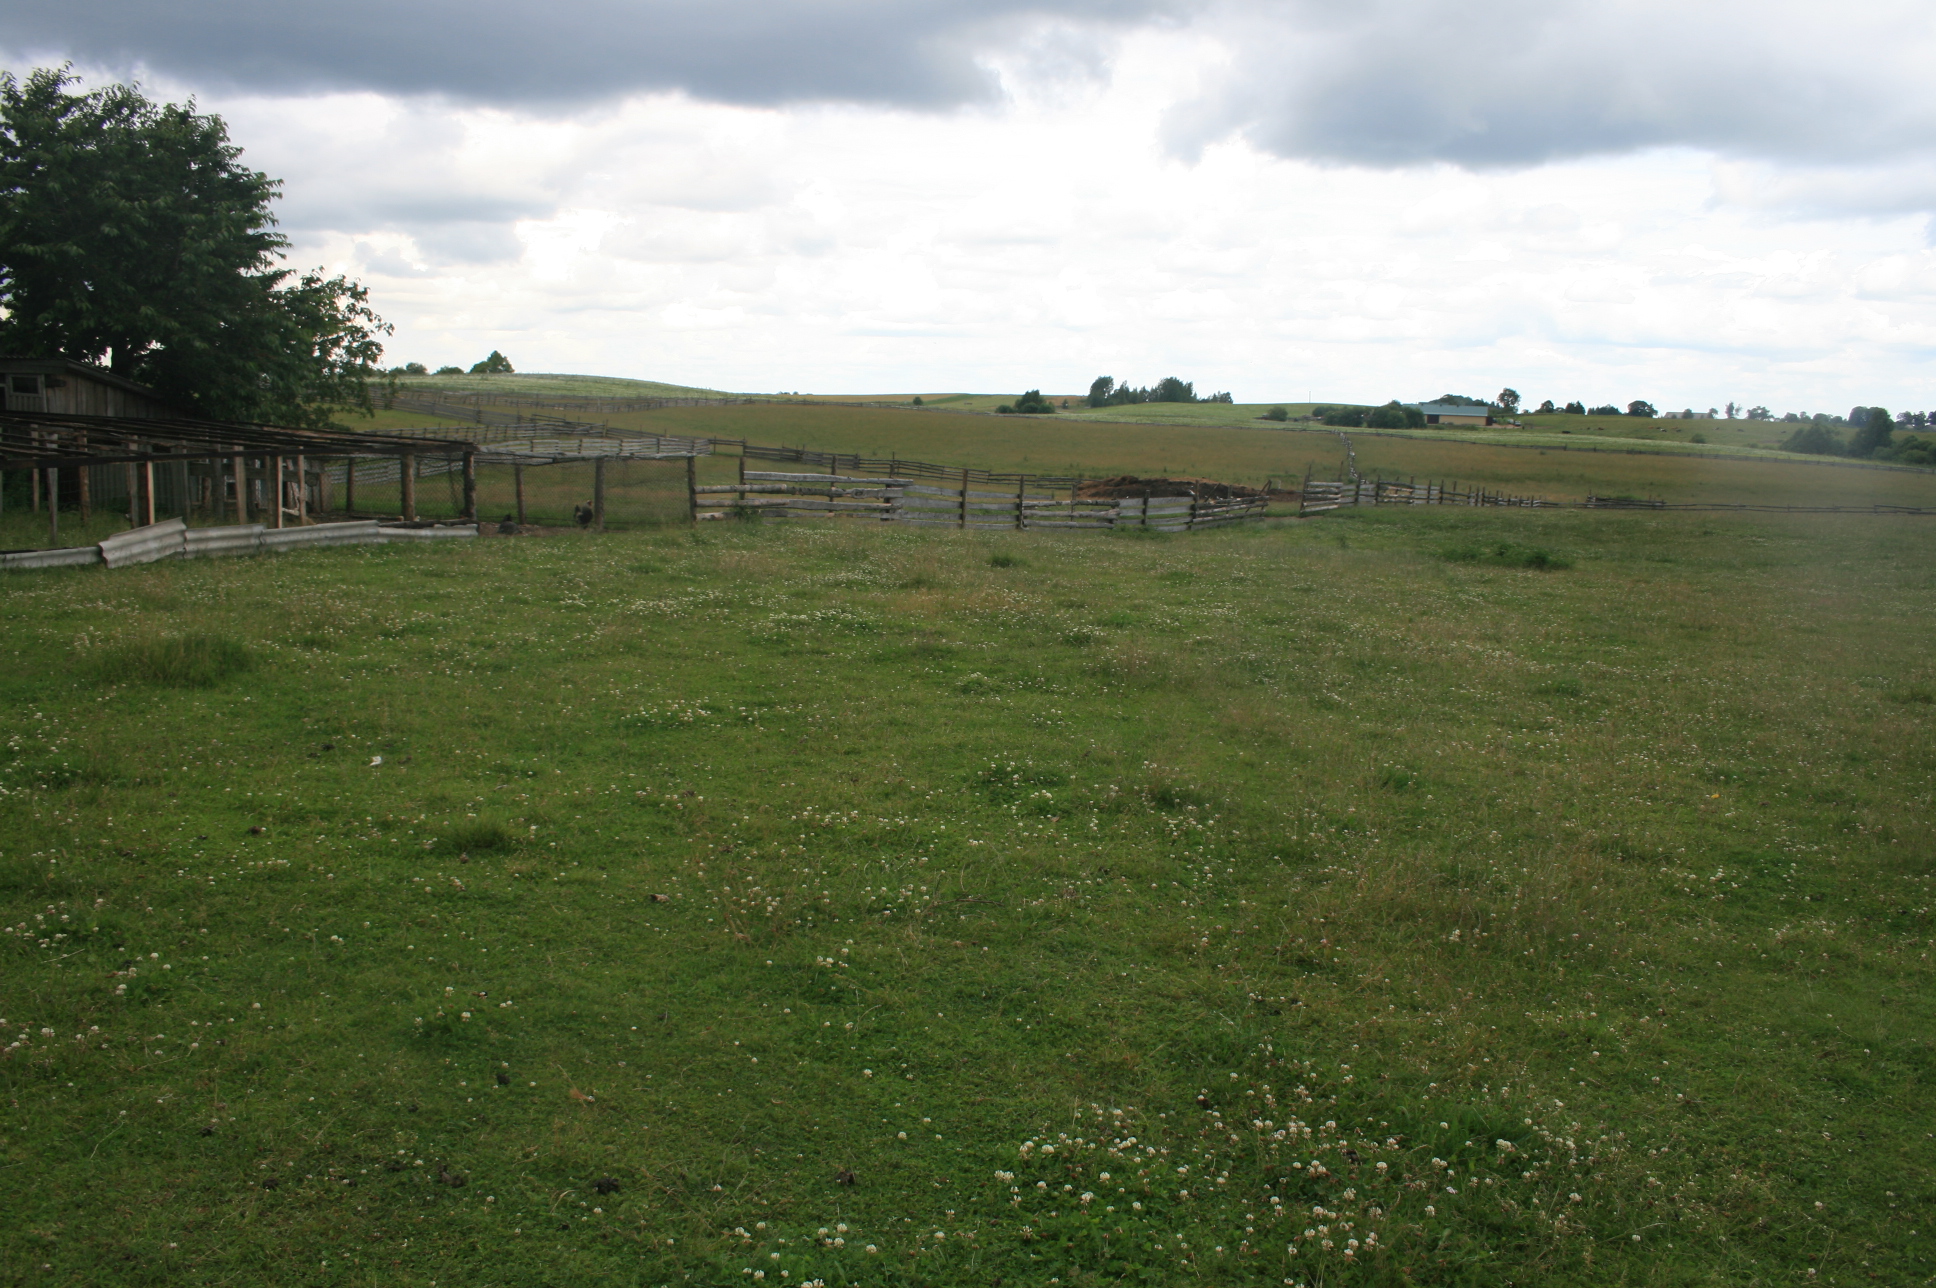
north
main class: Grassland
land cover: Grassland without tree/shrub cover
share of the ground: > 75 %
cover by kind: herbaceous plants 100 %
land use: Agriculture (excluding fallow land and kitchen gardens)
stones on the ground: < 10 %
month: July
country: LT
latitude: 56.0929
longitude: 22.0261
